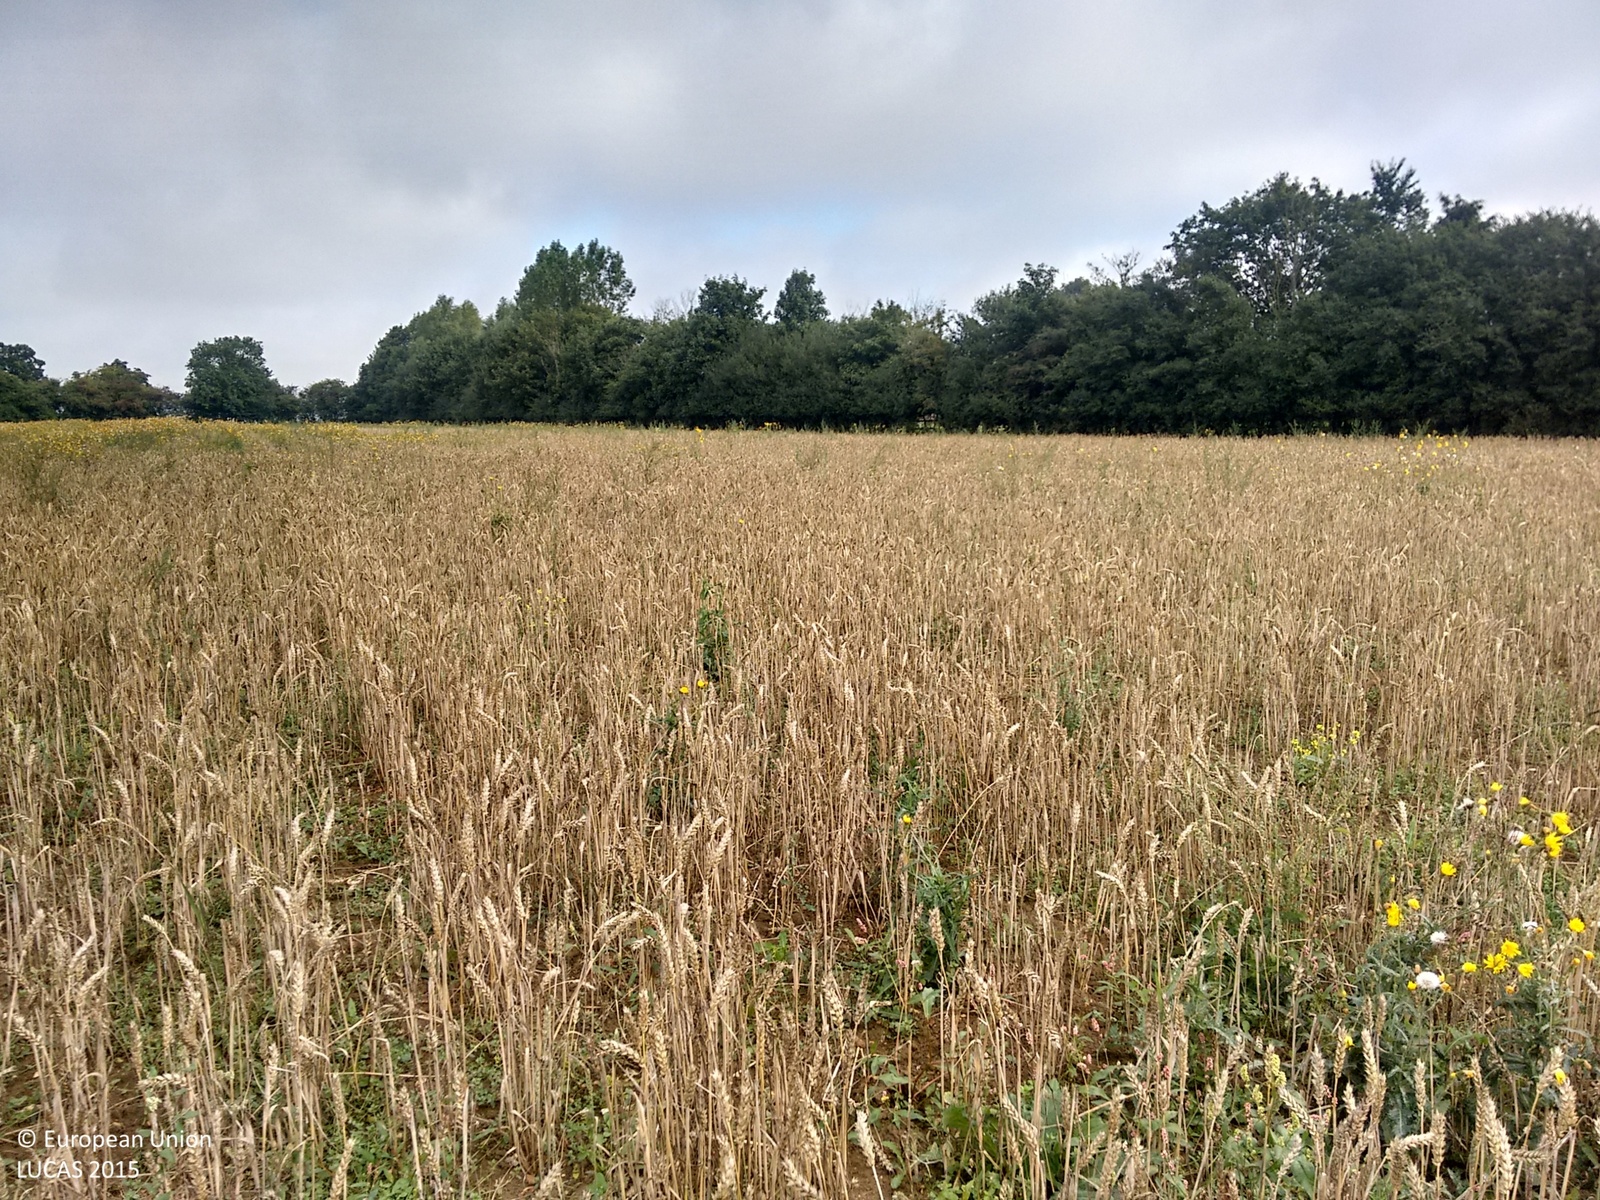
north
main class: Cropland
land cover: Common wheat
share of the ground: > 75 %
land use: Agriculture (excluding fallow land and kitchen gardens)
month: September
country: GB
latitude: 52.2001
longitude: 0.5650
